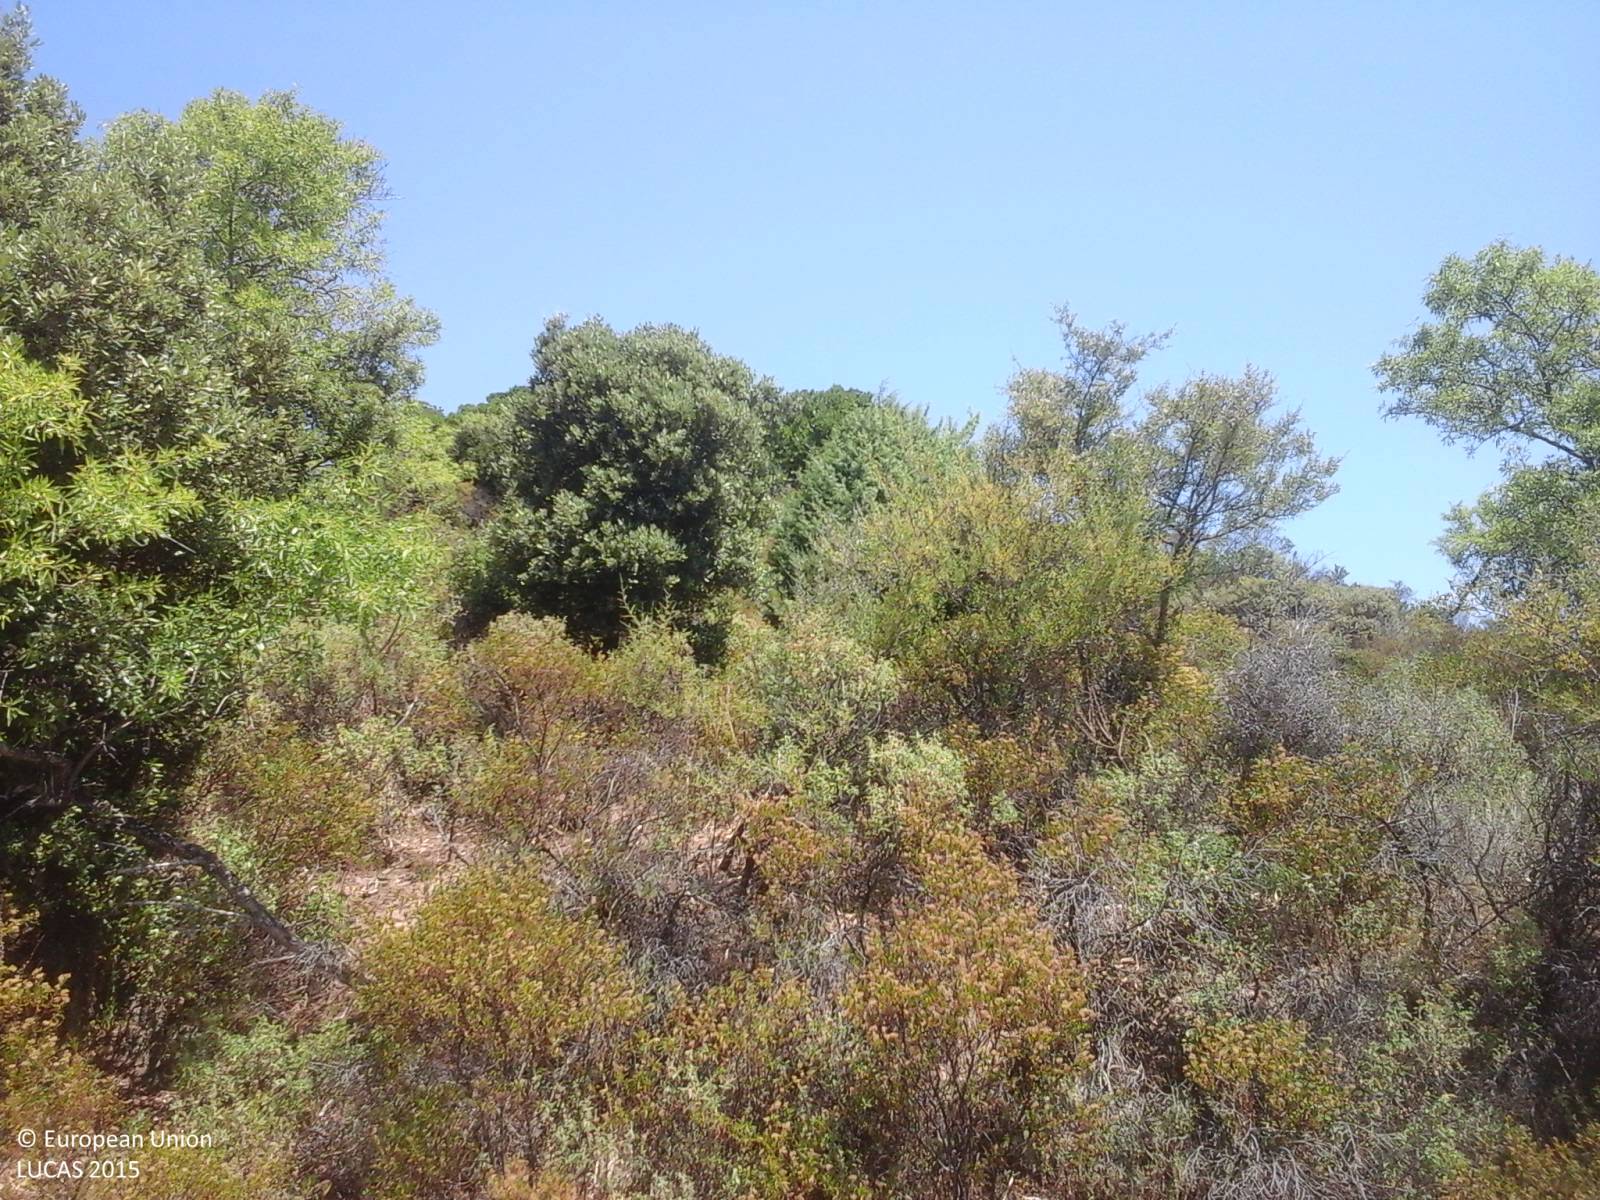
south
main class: Shrubland
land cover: Shrubland with sparse tree cover
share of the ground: > 75 %
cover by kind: shrubs 55 %, herbaceous plants 30 %, unconsolidated bare surface 10 %, broadleaved forest trees 5 %
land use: Semi-natural and natural areas not in use
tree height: < 5 m
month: June
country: IT
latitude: 39.2513
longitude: 9.4127
